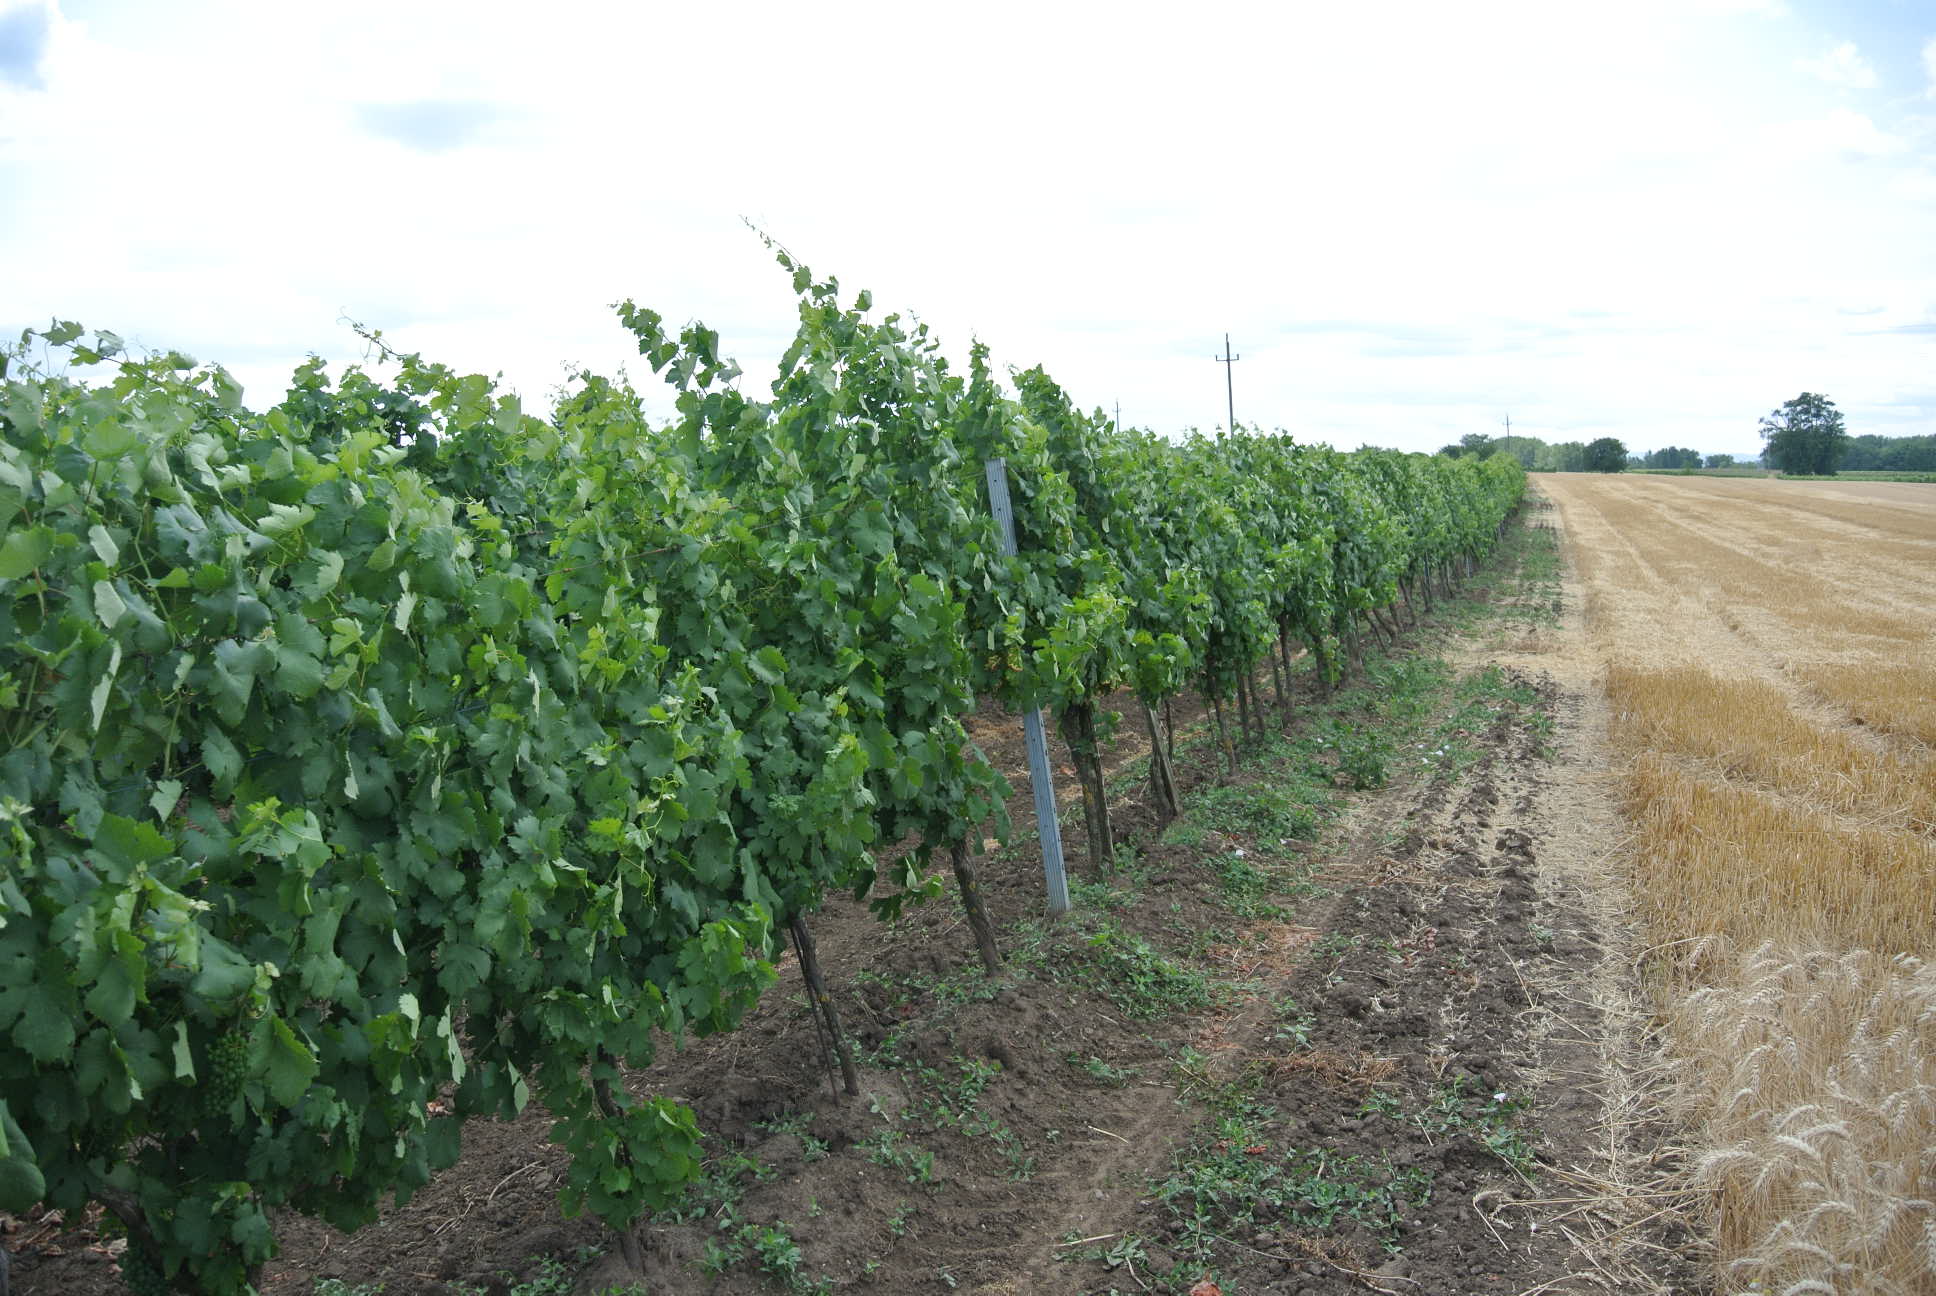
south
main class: Cropland
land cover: Durum wheat
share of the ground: > 75 %
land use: Agriculture (excluding fallow land and kitchen gardens)
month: July
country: AT
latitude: 47.8488
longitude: 16.8348
